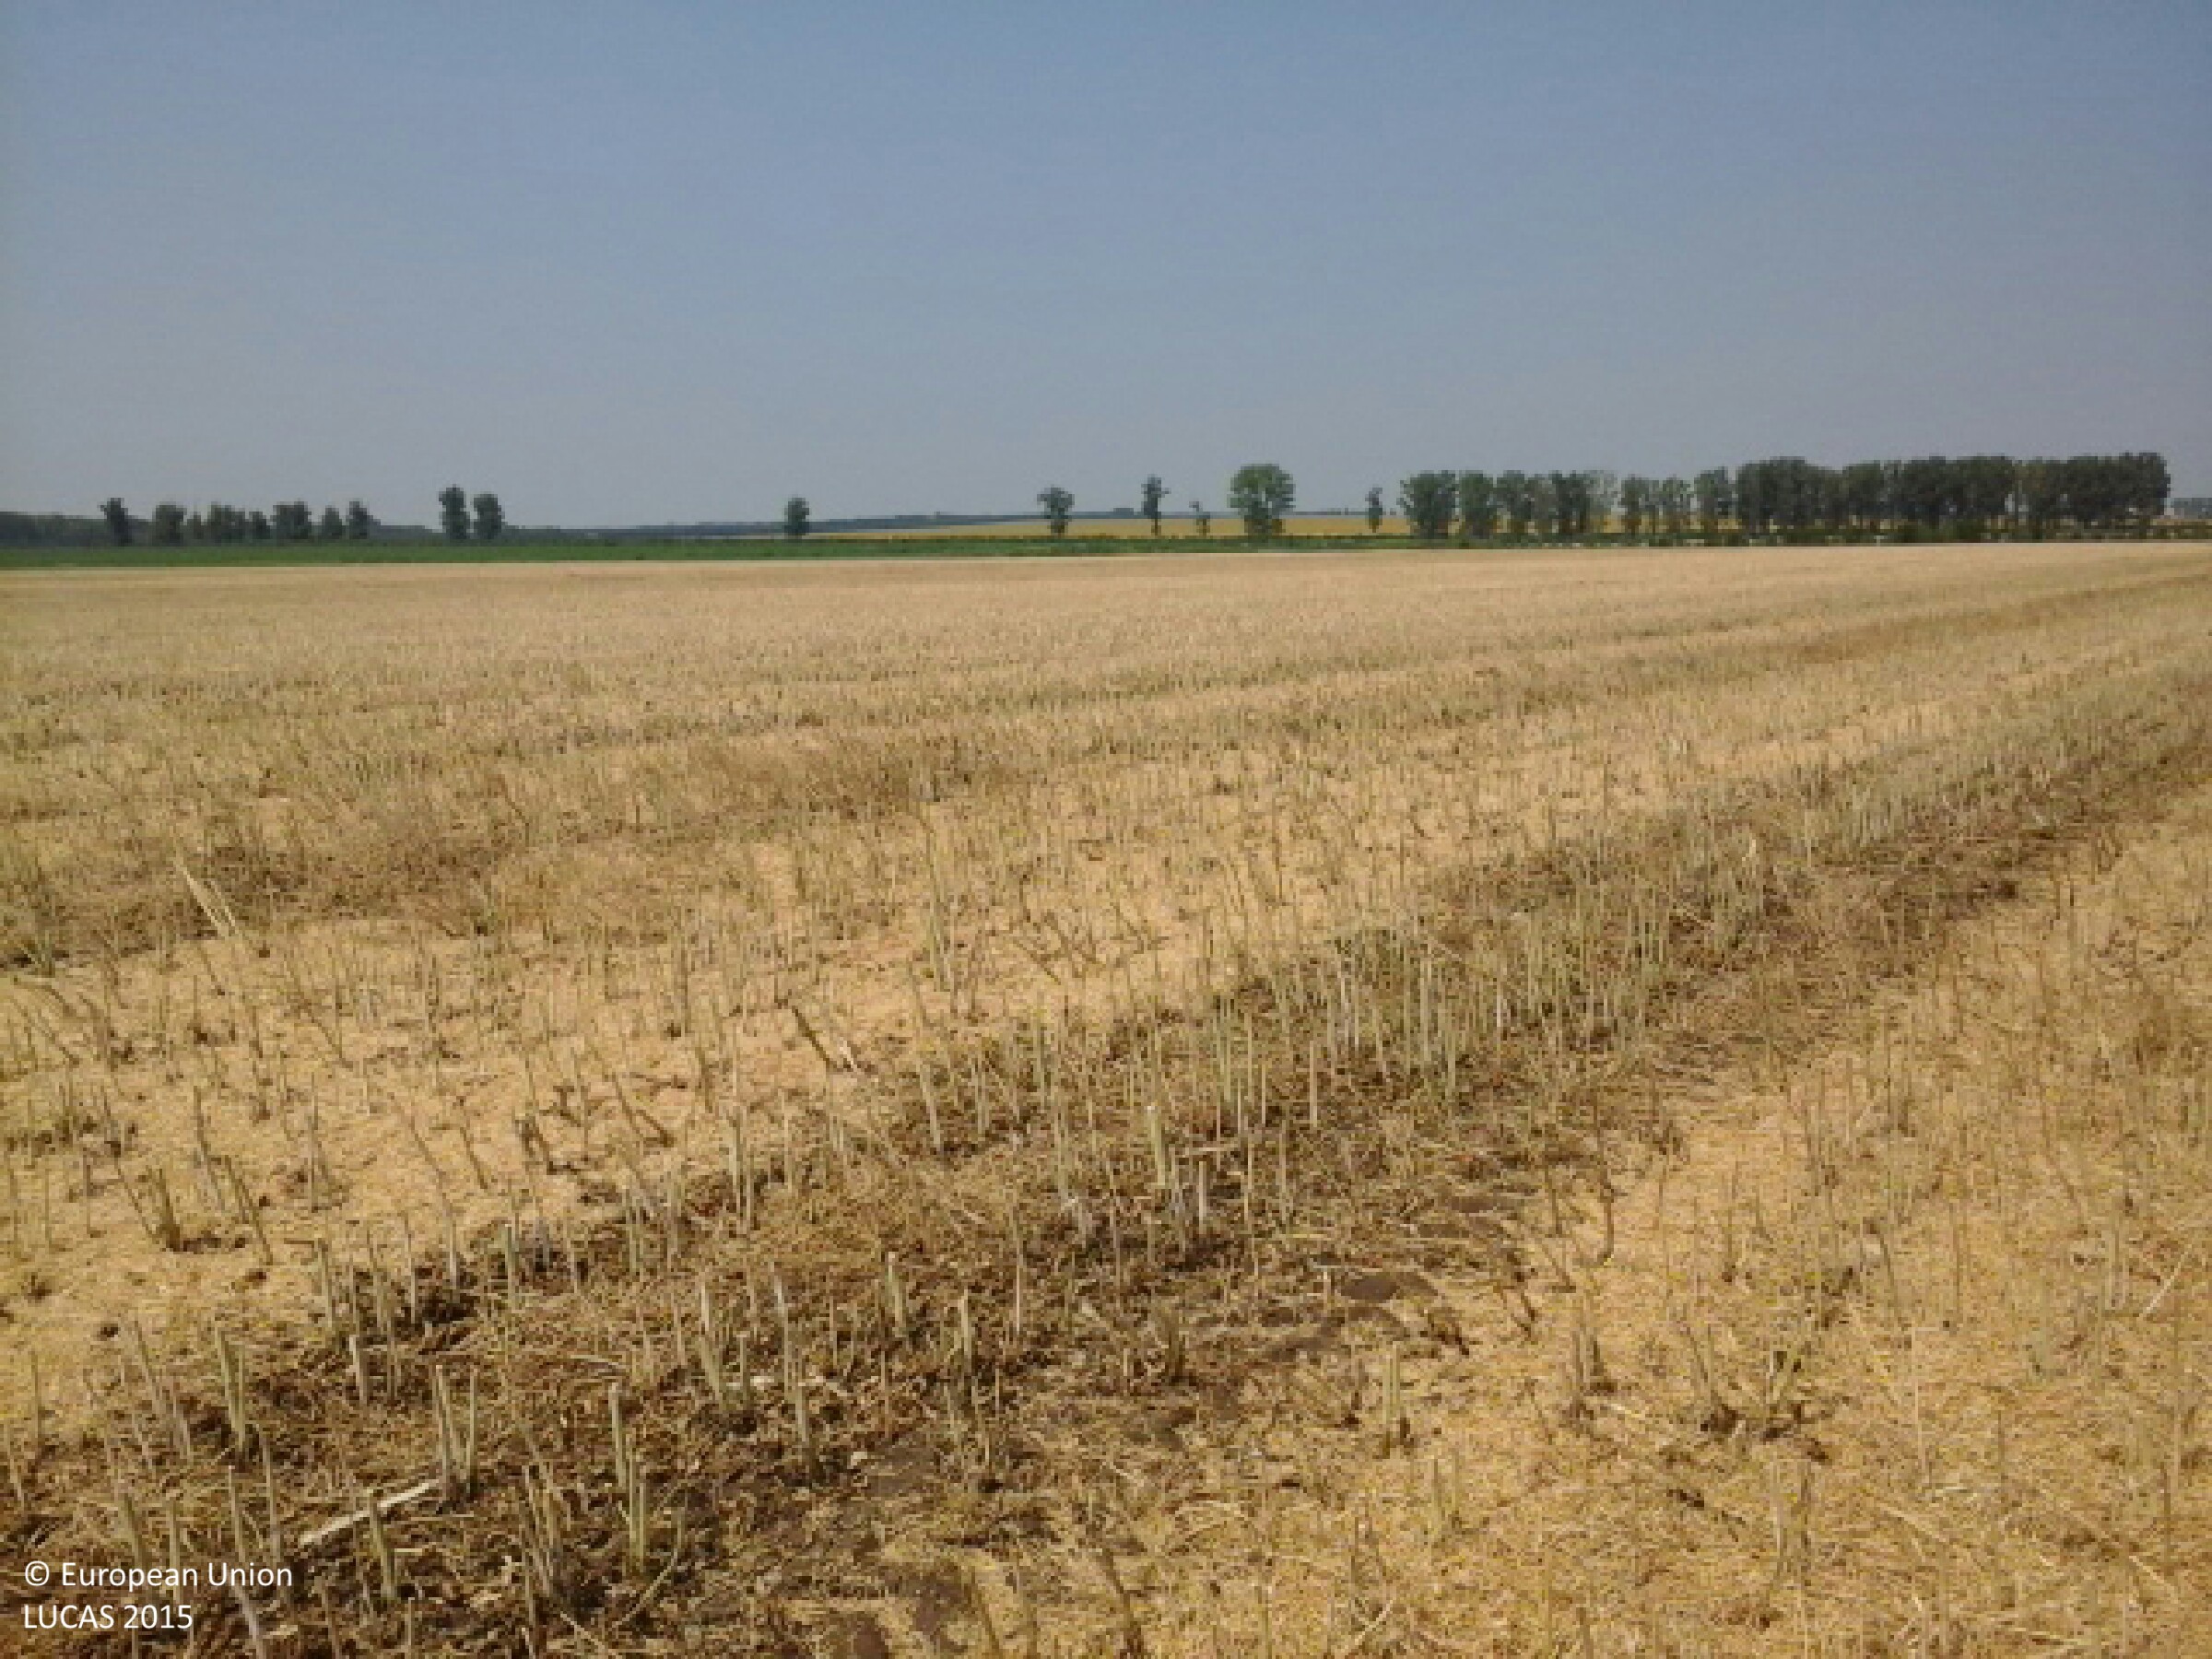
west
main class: Cropland
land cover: Rape and turnip rape
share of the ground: < 10 %
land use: Agriculture (excluding fallow land and kitchen gardens)
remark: Harvested field
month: July
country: HU
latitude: 48.0951
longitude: 21.1181
